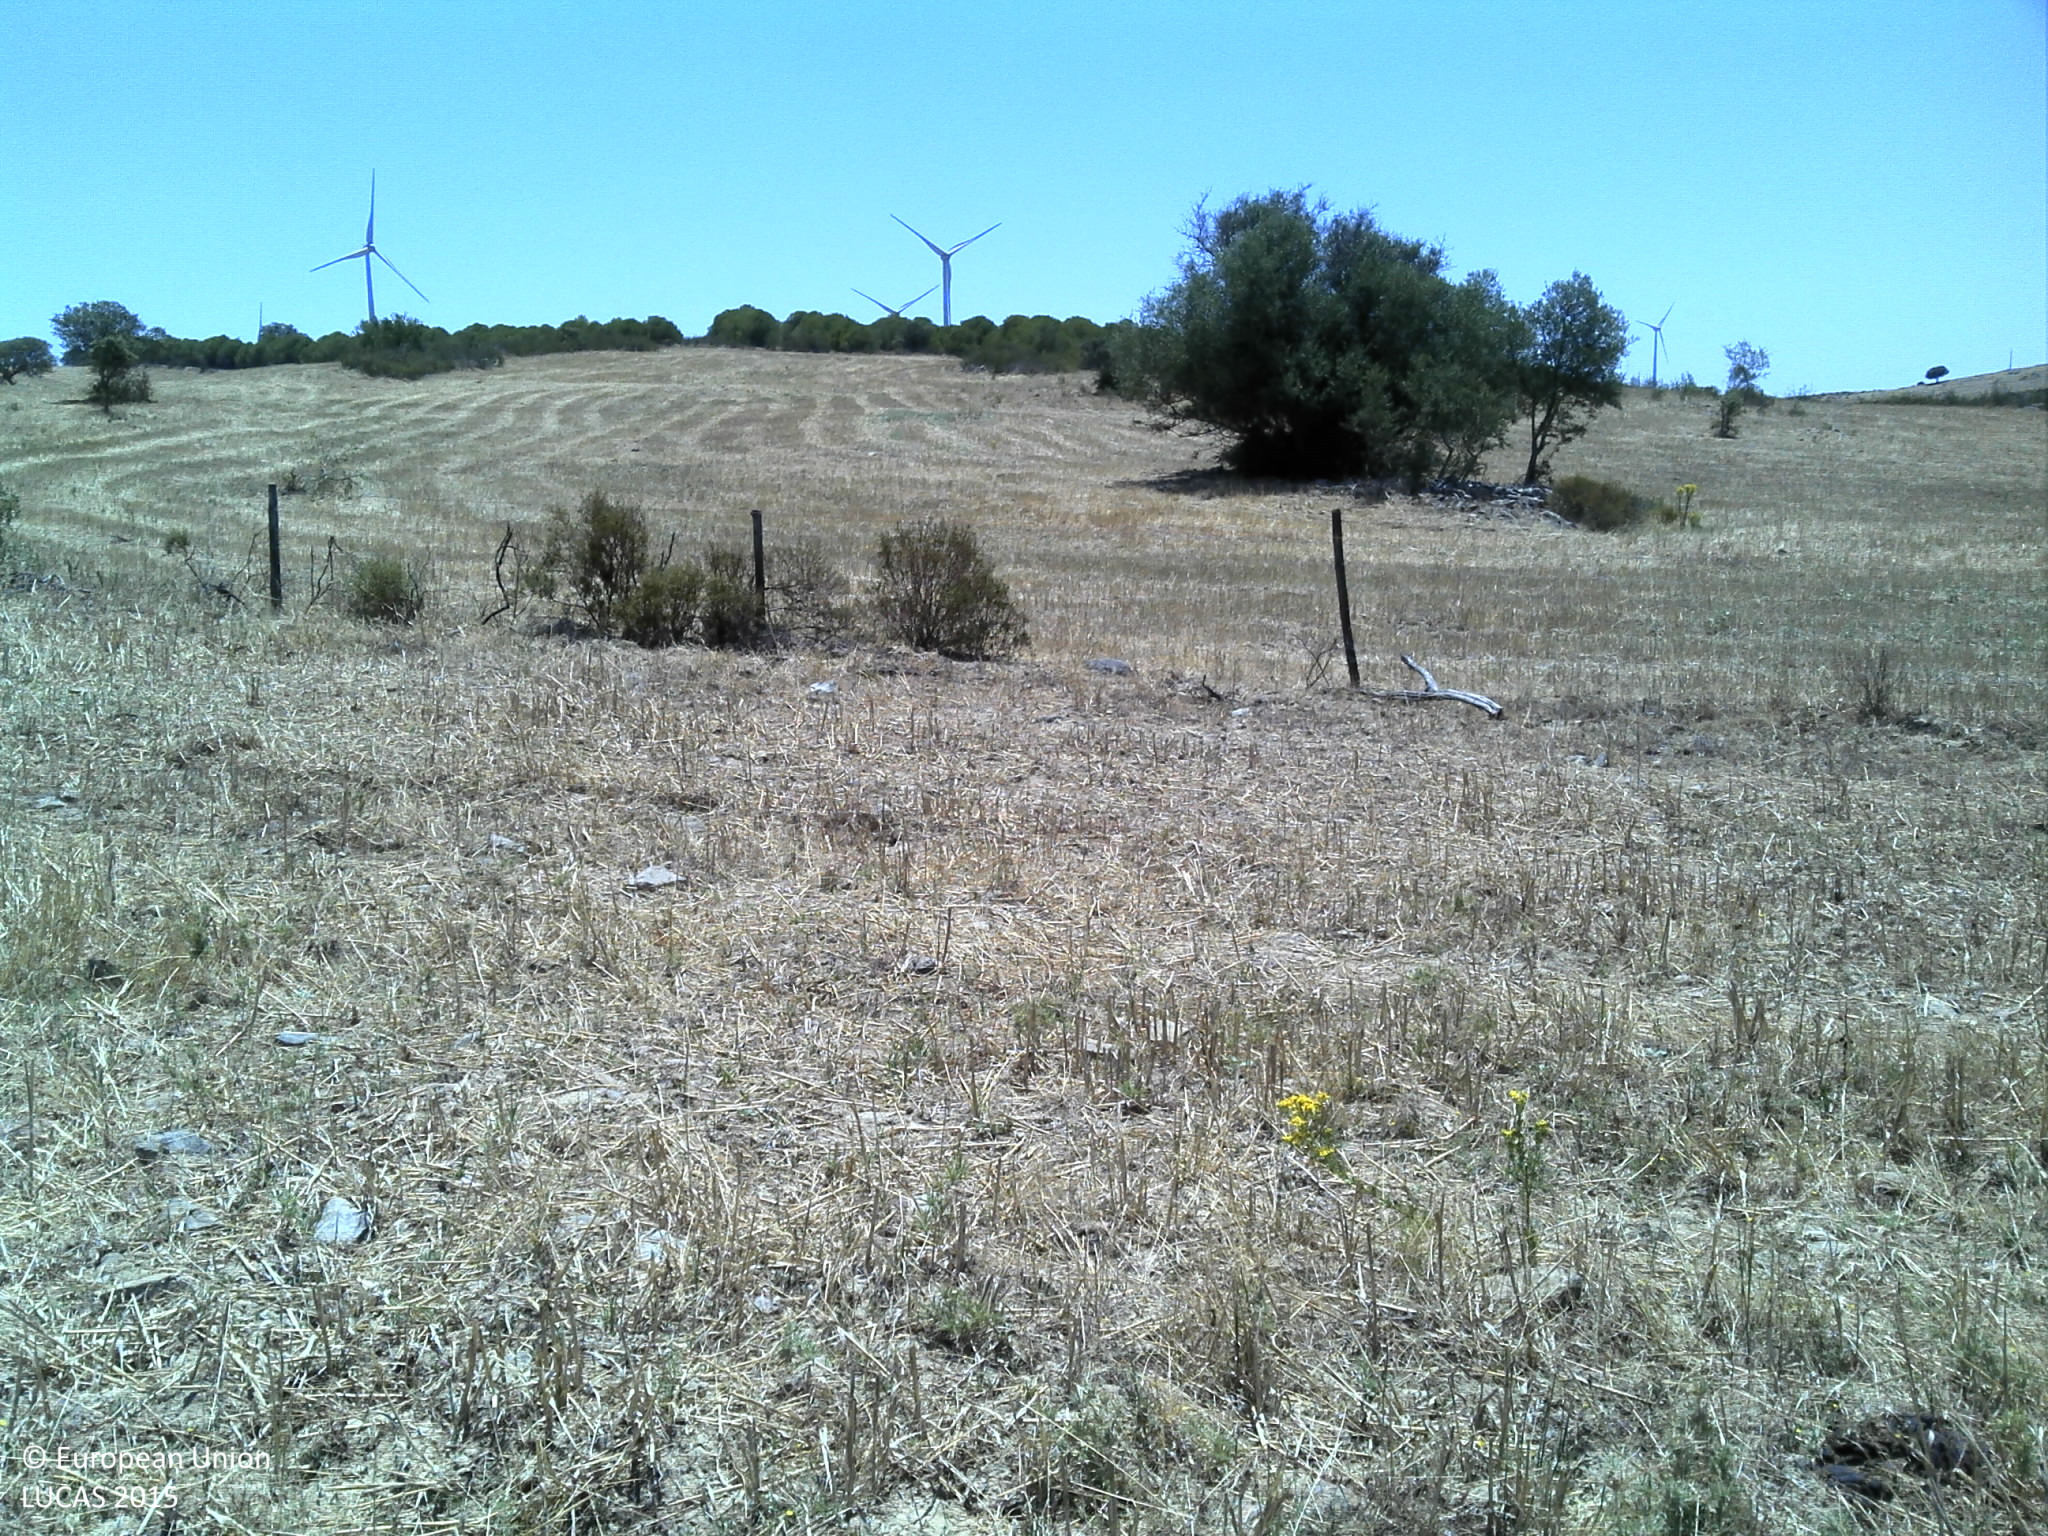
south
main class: Cropland
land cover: Oats
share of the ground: 50 - 75 %
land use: Agriculture (excluding fallow land and kitchen gardens)
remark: Harvested field
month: July
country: PT
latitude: 37.5047
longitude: -7.8566
